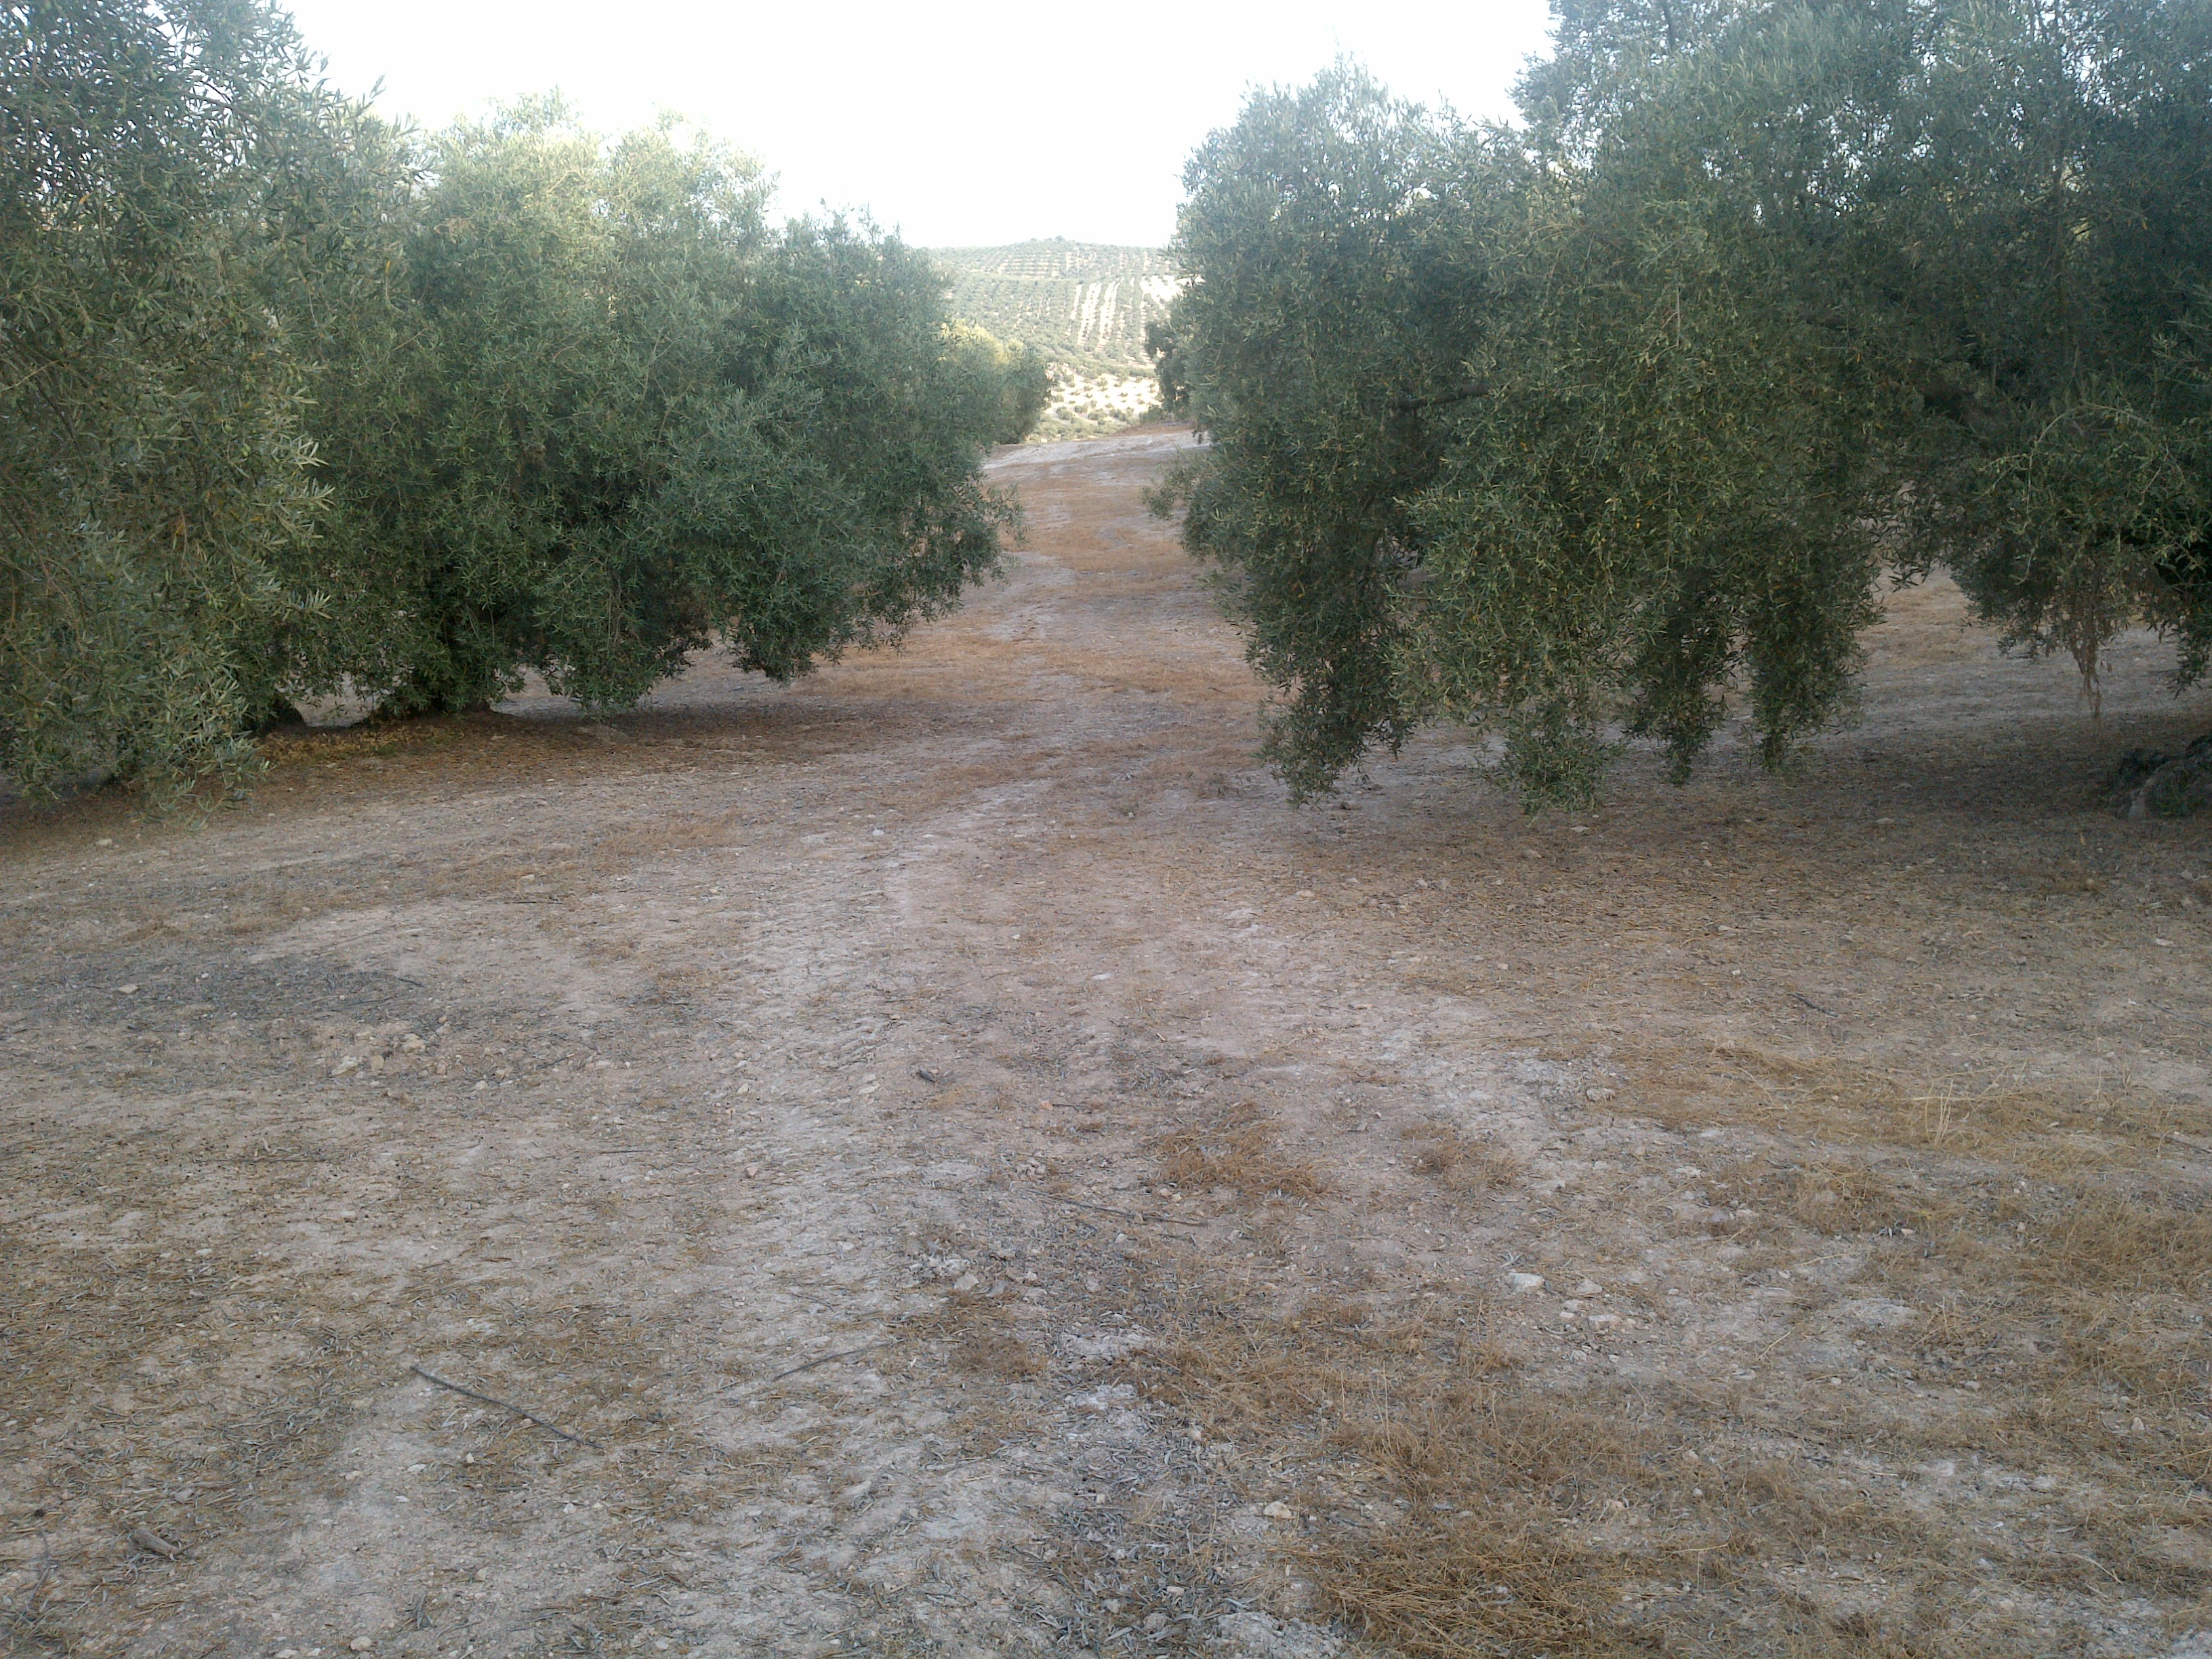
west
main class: Cropland
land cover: Olive groves
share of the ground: 50 - 75 %
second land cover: Spontaneously vegetated surfaces
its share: 10 - 25 %
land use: Agriculture (excluding fallow land and kitchen gardens)
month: July
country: ES
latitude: 37.3807
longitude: -4.4004
